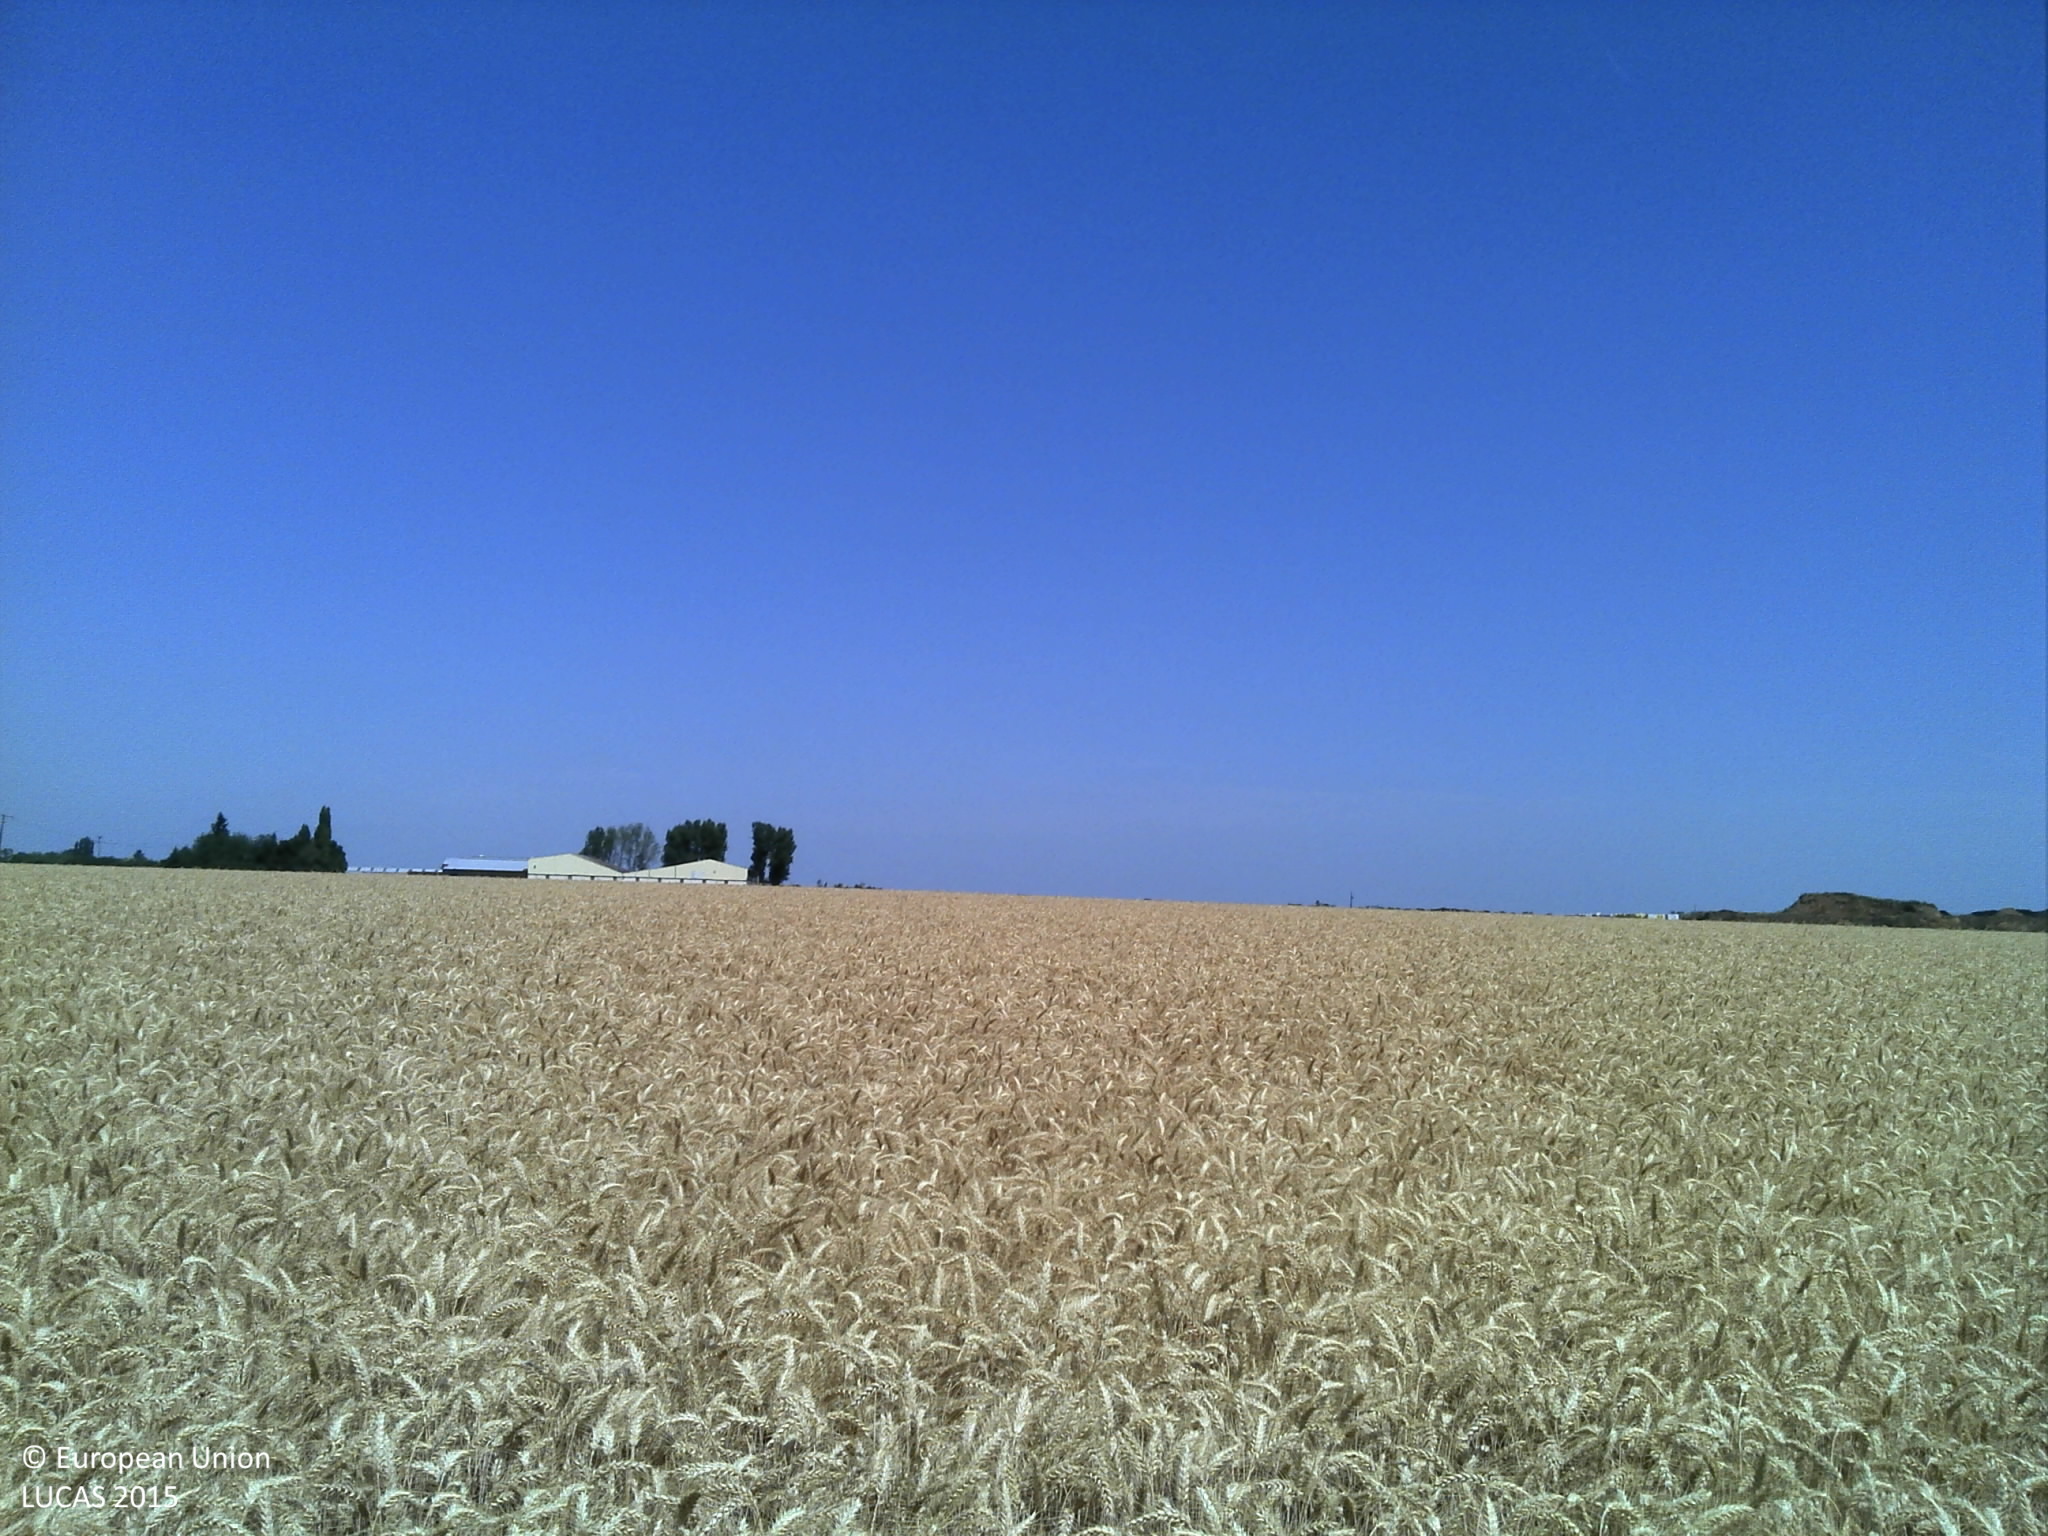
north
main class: Cropland
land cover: Durum wheat
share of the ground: > 75 %
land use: Agriculture (excluding fallow land and kitchen gardens)
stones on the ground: < 10 %
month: July
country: FR
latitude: 48.4188
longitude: 1.9738
